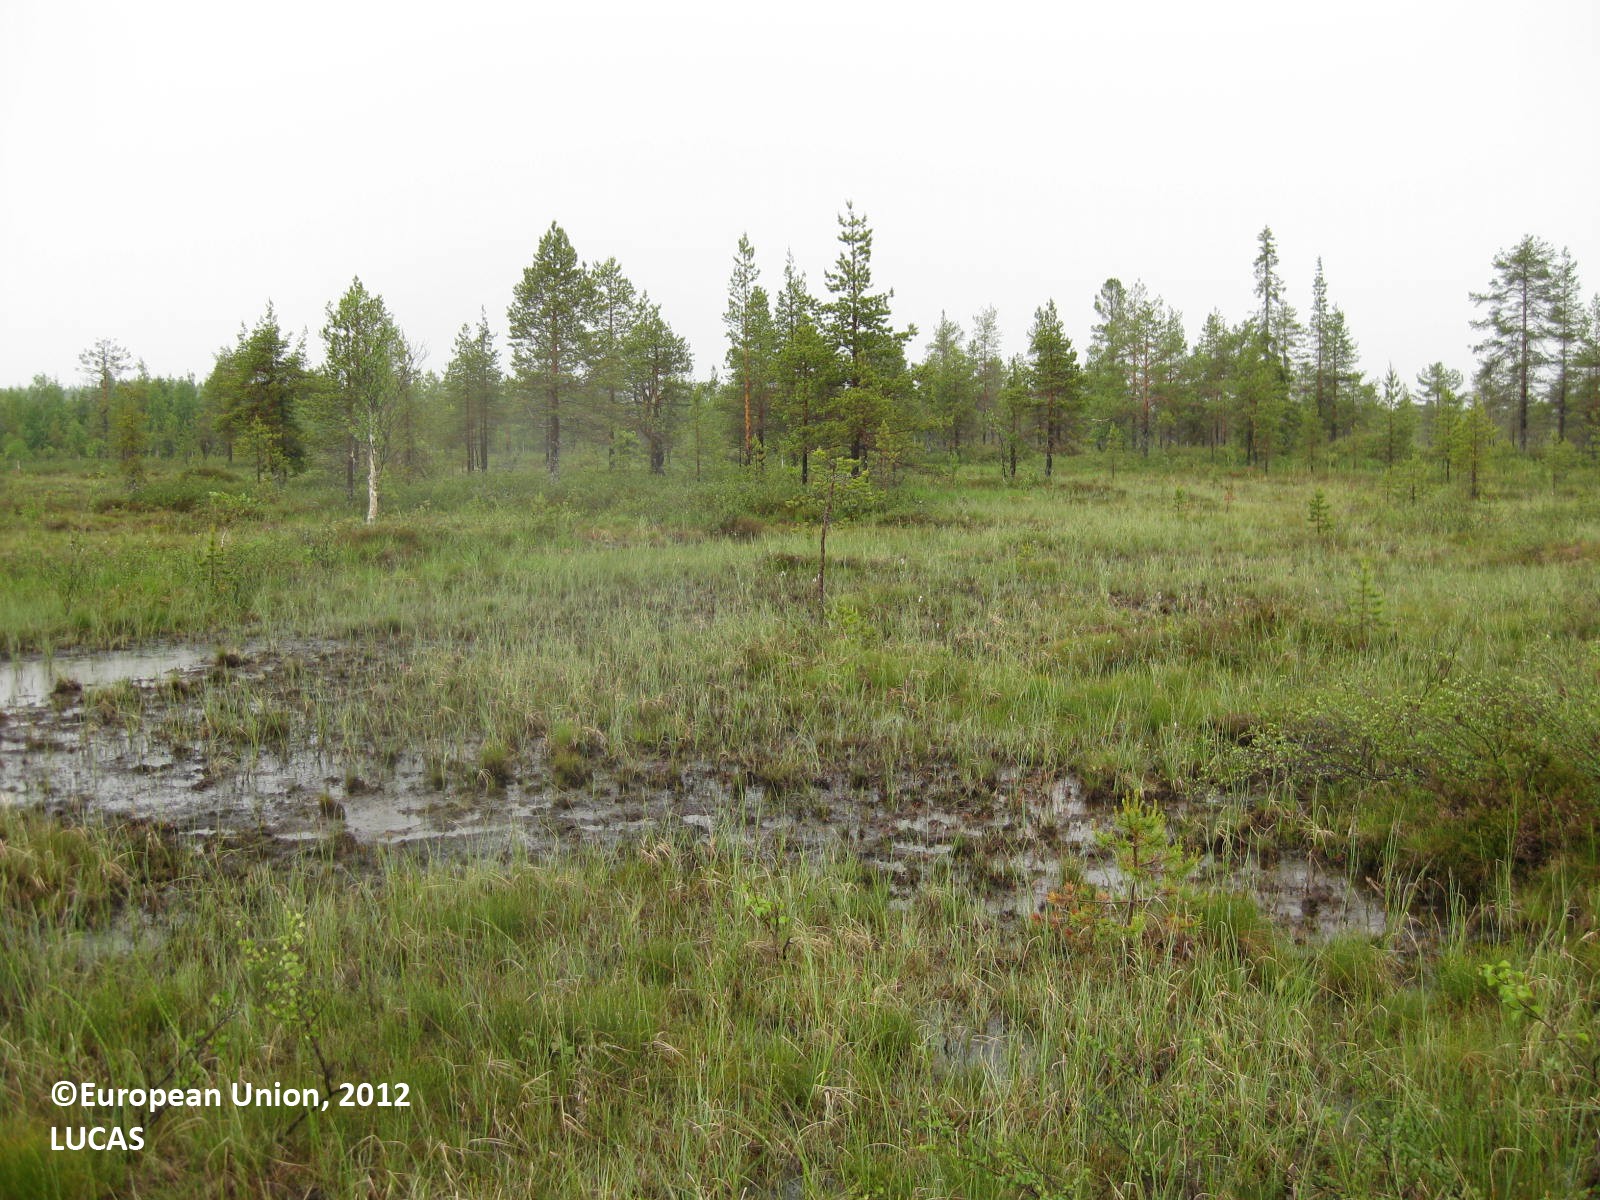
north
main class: Woodland
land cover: Pine dominated mixed woodland
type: boreal forest
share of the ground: 10 - 25 %
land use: Semi-natural and natural areas not in use
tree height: > 5 m
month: July
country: FI
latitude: 65.6702
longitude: 29.4448
